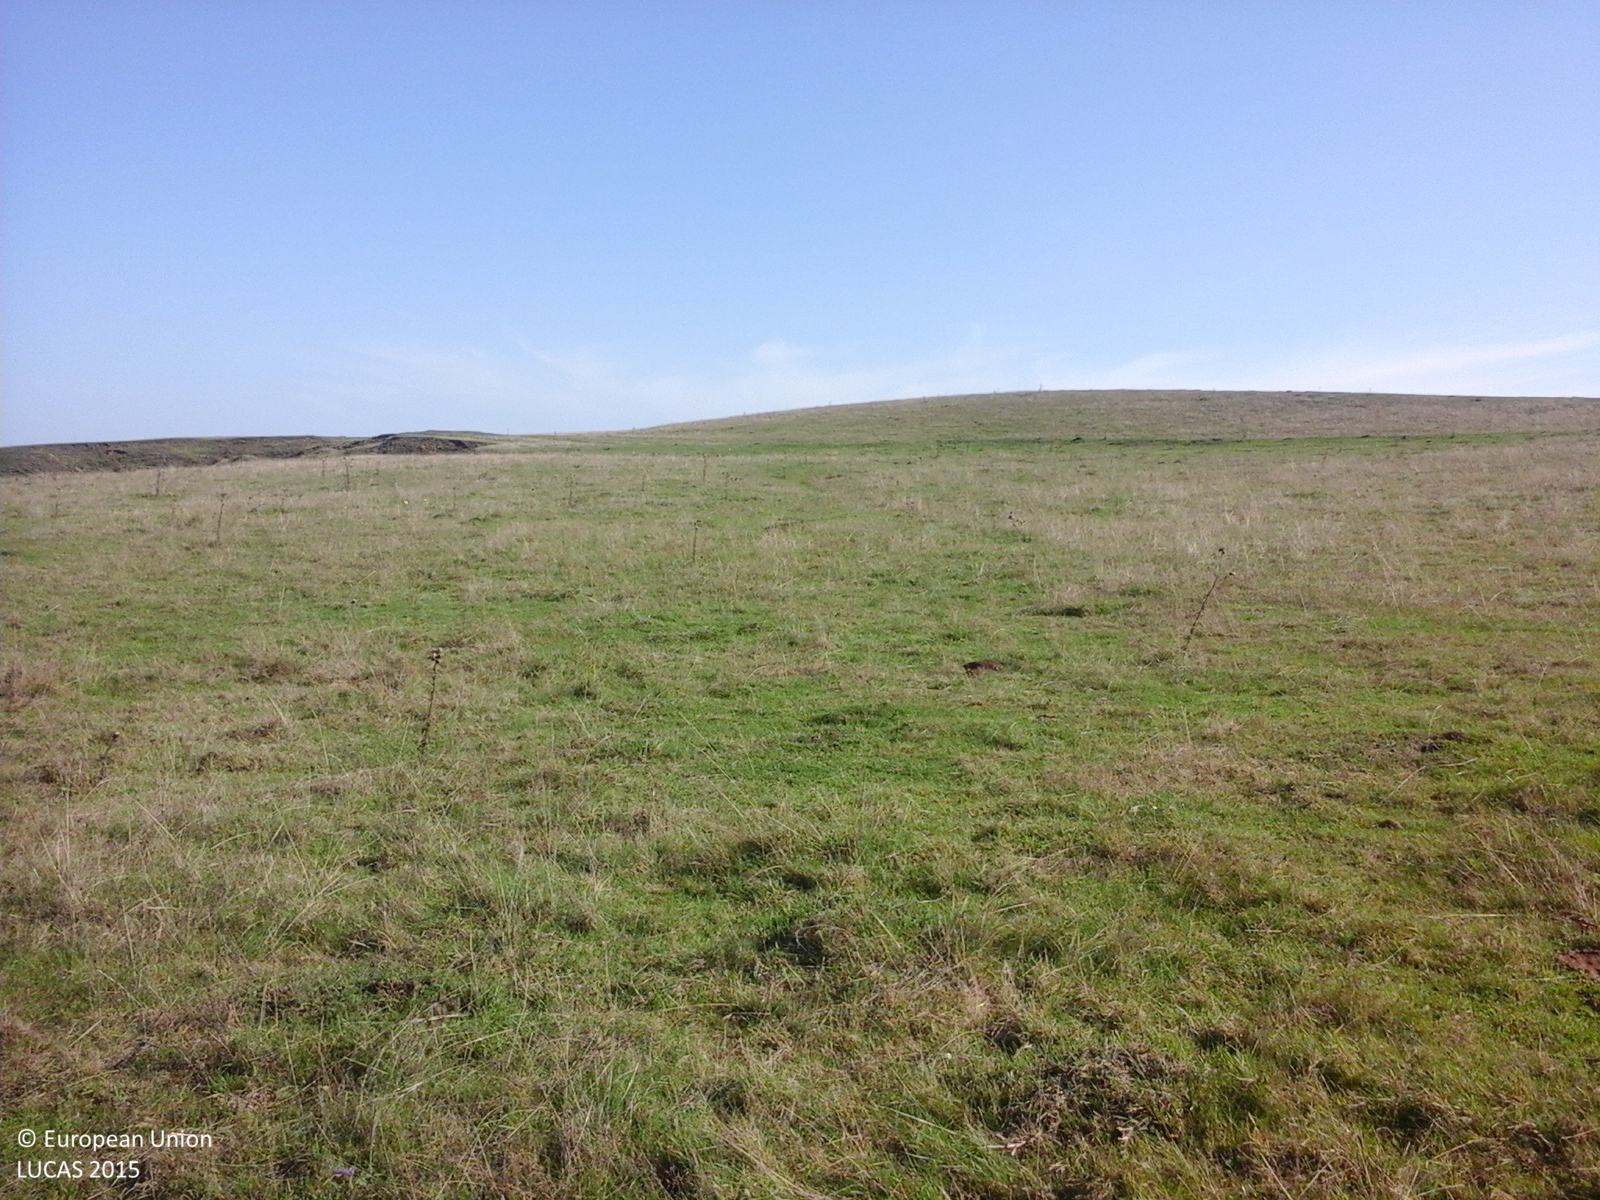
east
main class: Grassland
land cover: Grassland without tree/shrub cover
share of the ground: > 75 %
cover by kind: herbaceous plants 100 %
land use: Agriculture (excluding fallow land and kitchen gardens)
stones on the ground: < 10 %
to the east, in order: Grassland without tree/shrub cover; Spontaneously vegetated surfaces; Grassland without tree/shrub cover
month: October
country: RO
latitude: 46.2561
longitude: 23.6509
